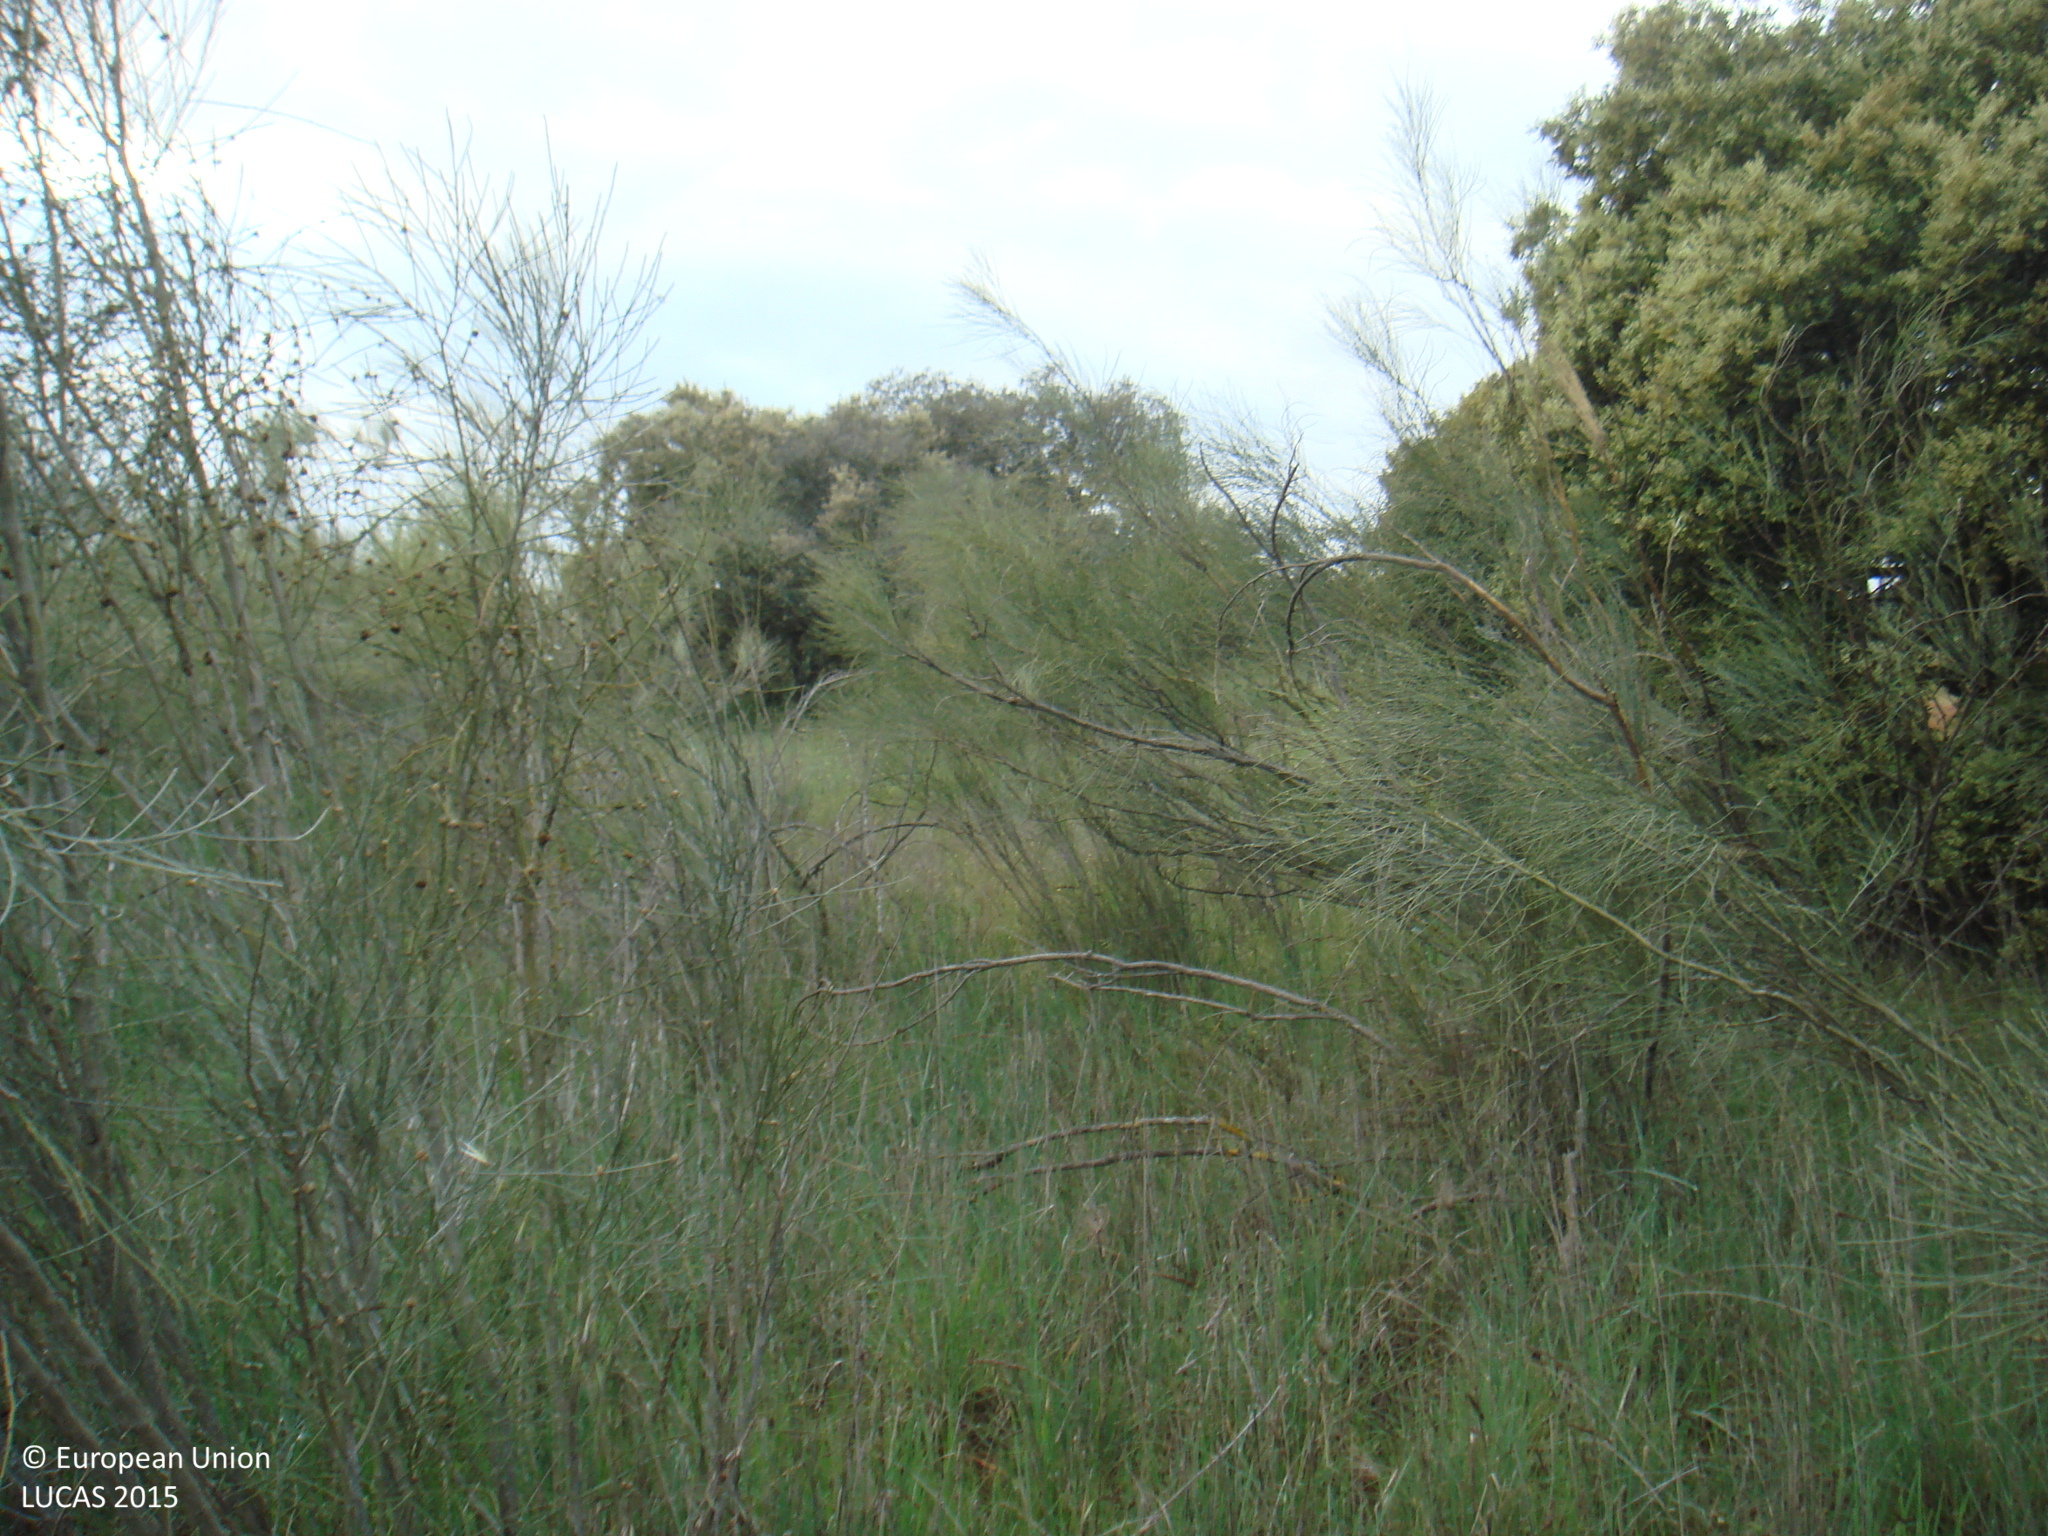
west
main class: Shrubland
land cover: Shrubland with sparse tree cover
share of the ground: 50 - 75 %
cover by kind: shrubs 55 %, herbaceous plants 40 %, broadleaved forest trees 5 %
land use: Semi-natural and natural areas not in use
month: April
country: ES
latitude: 38.2316
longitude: -5.3017
